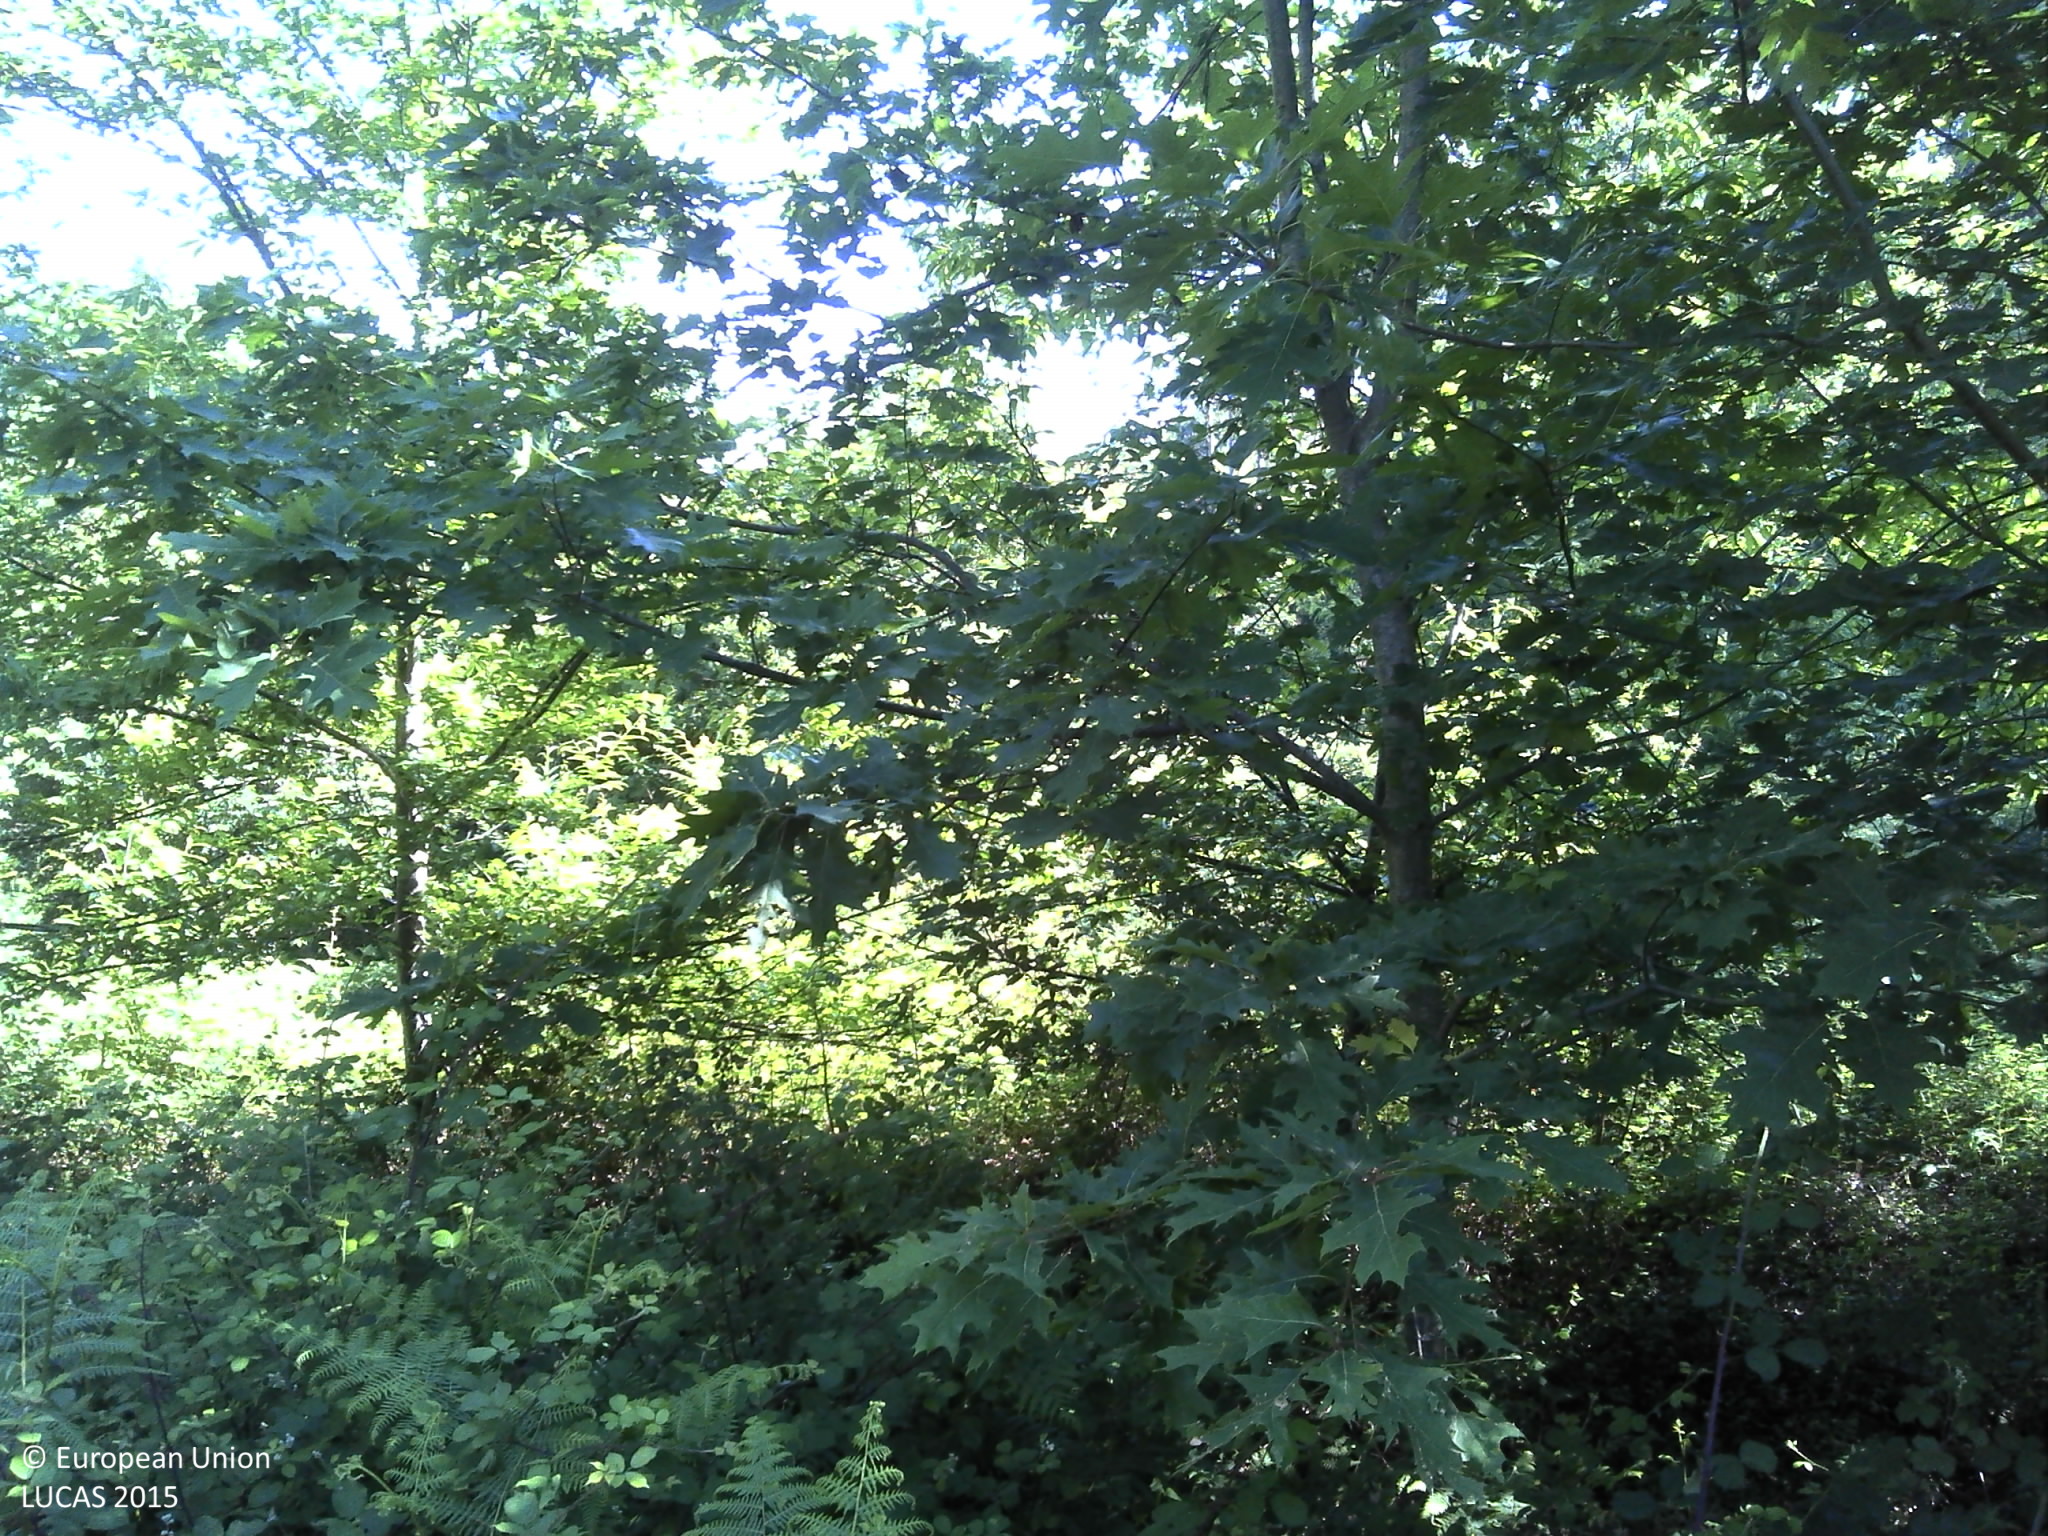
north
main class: Woodland
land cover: Pine dominated mixed woodland
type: coniferous forest of the mediterranean region
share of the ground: 50 - 75 %
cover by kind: coniferous forest trees 75 %, broadleaved forest trees 25 %
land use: Forestry
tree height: > 5 m
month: June
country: PT
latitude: 41.8462
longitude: -8.4541
